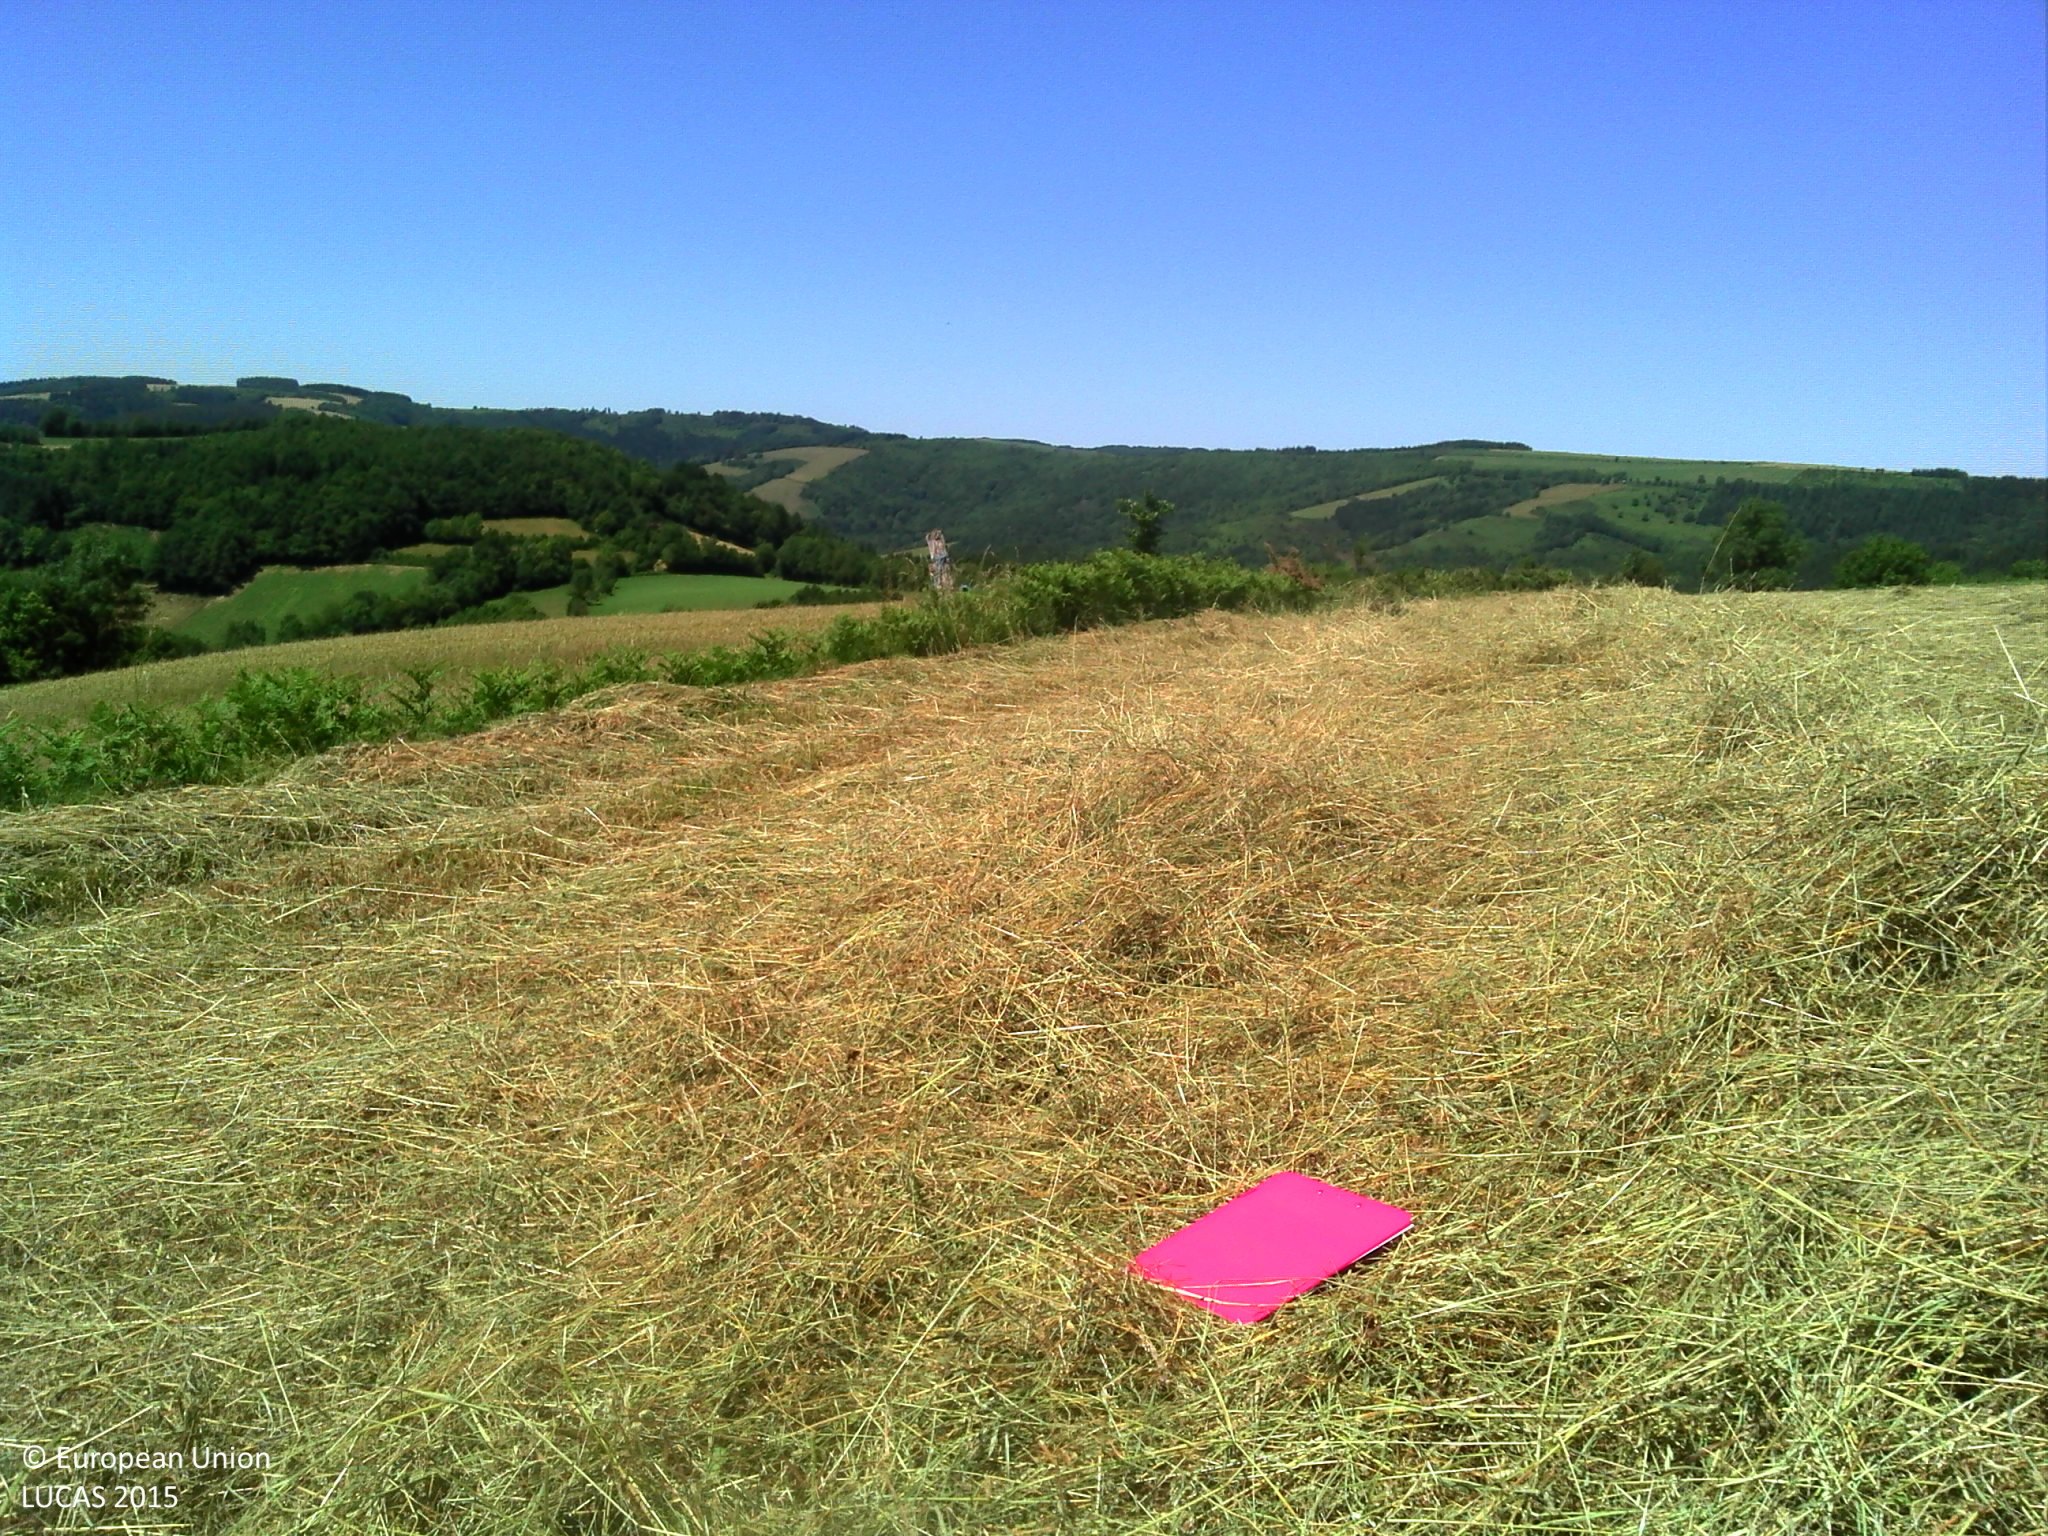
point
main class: Grassland
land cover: Grassland without tree/shrub cover
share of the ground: > 75 %
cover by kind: herbaceous plants 100 %
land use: Agriculture (excluding fallow land and kitchen gardens)
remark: Harvested field
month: June
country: FR
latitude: 43.7451
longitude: 2.6425
